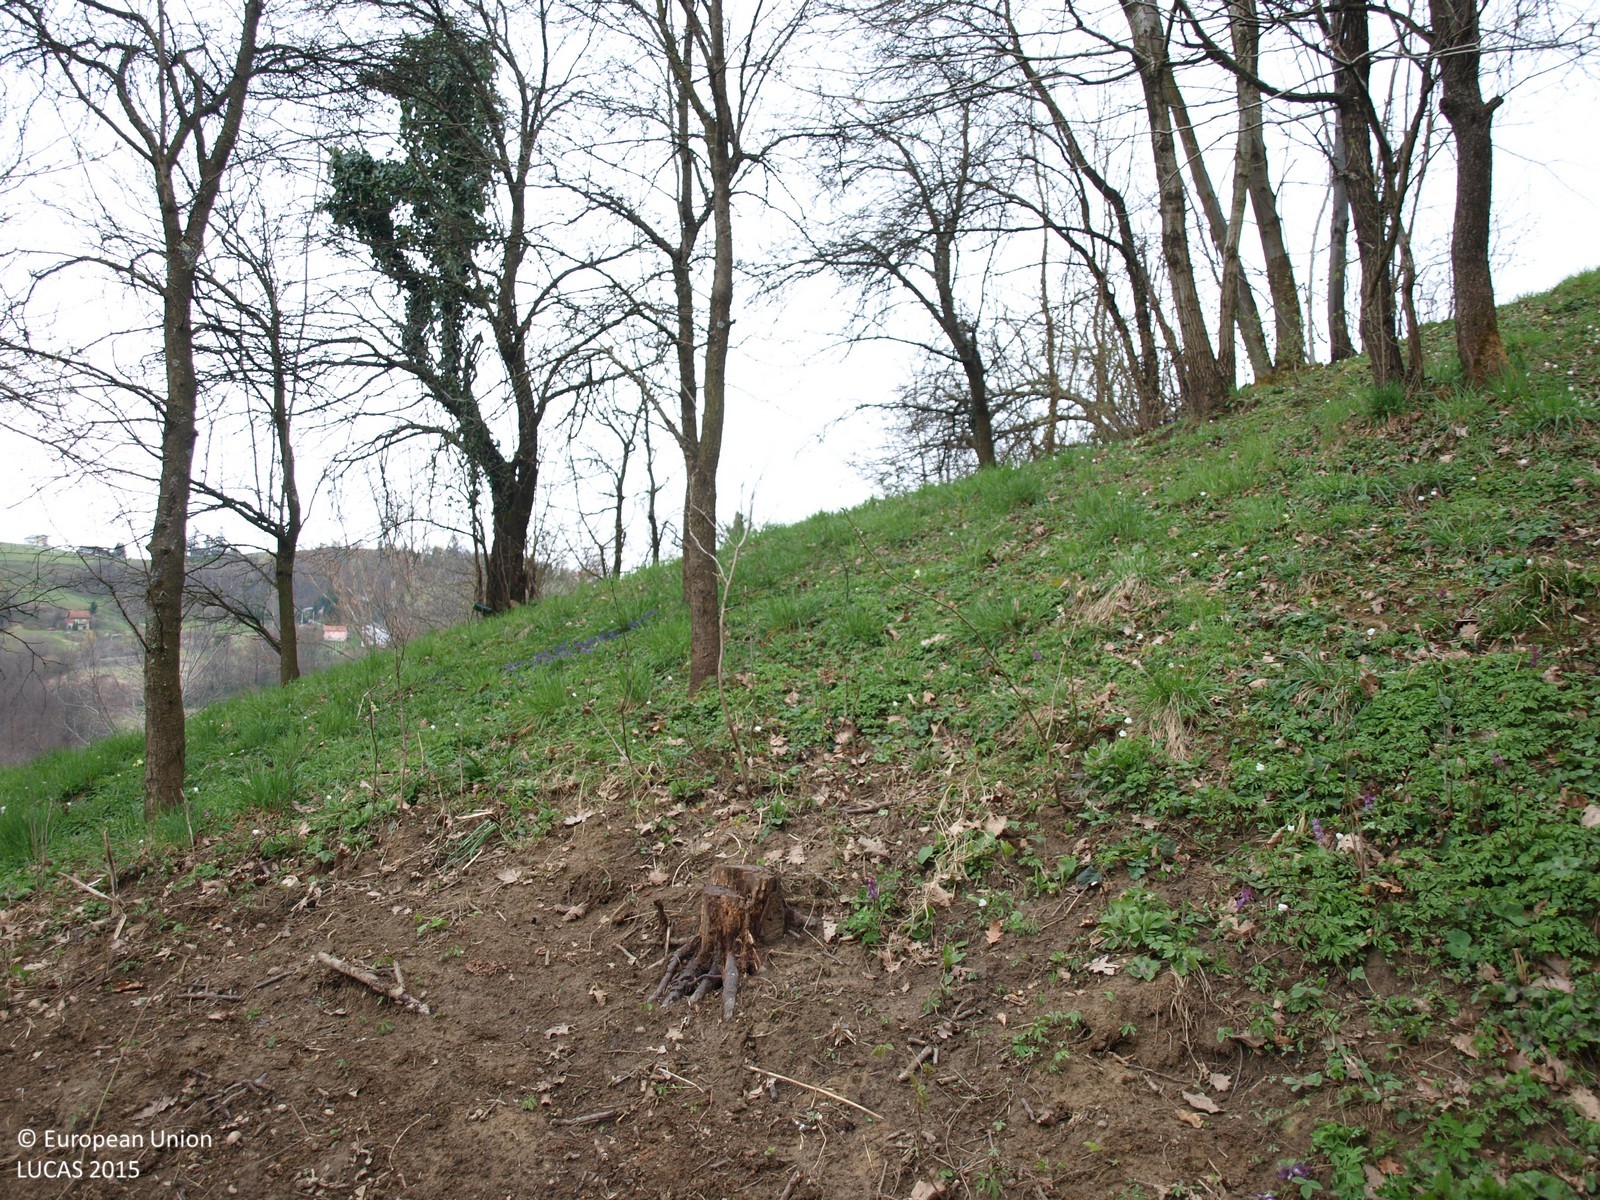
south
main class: Cropland
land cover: Other fruit trees and berries
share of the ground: > 75 %
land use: Agriculture (excluding fallow land and kitchen gardens)
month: April
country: HR
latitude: 46.2178
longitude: 15.6893
